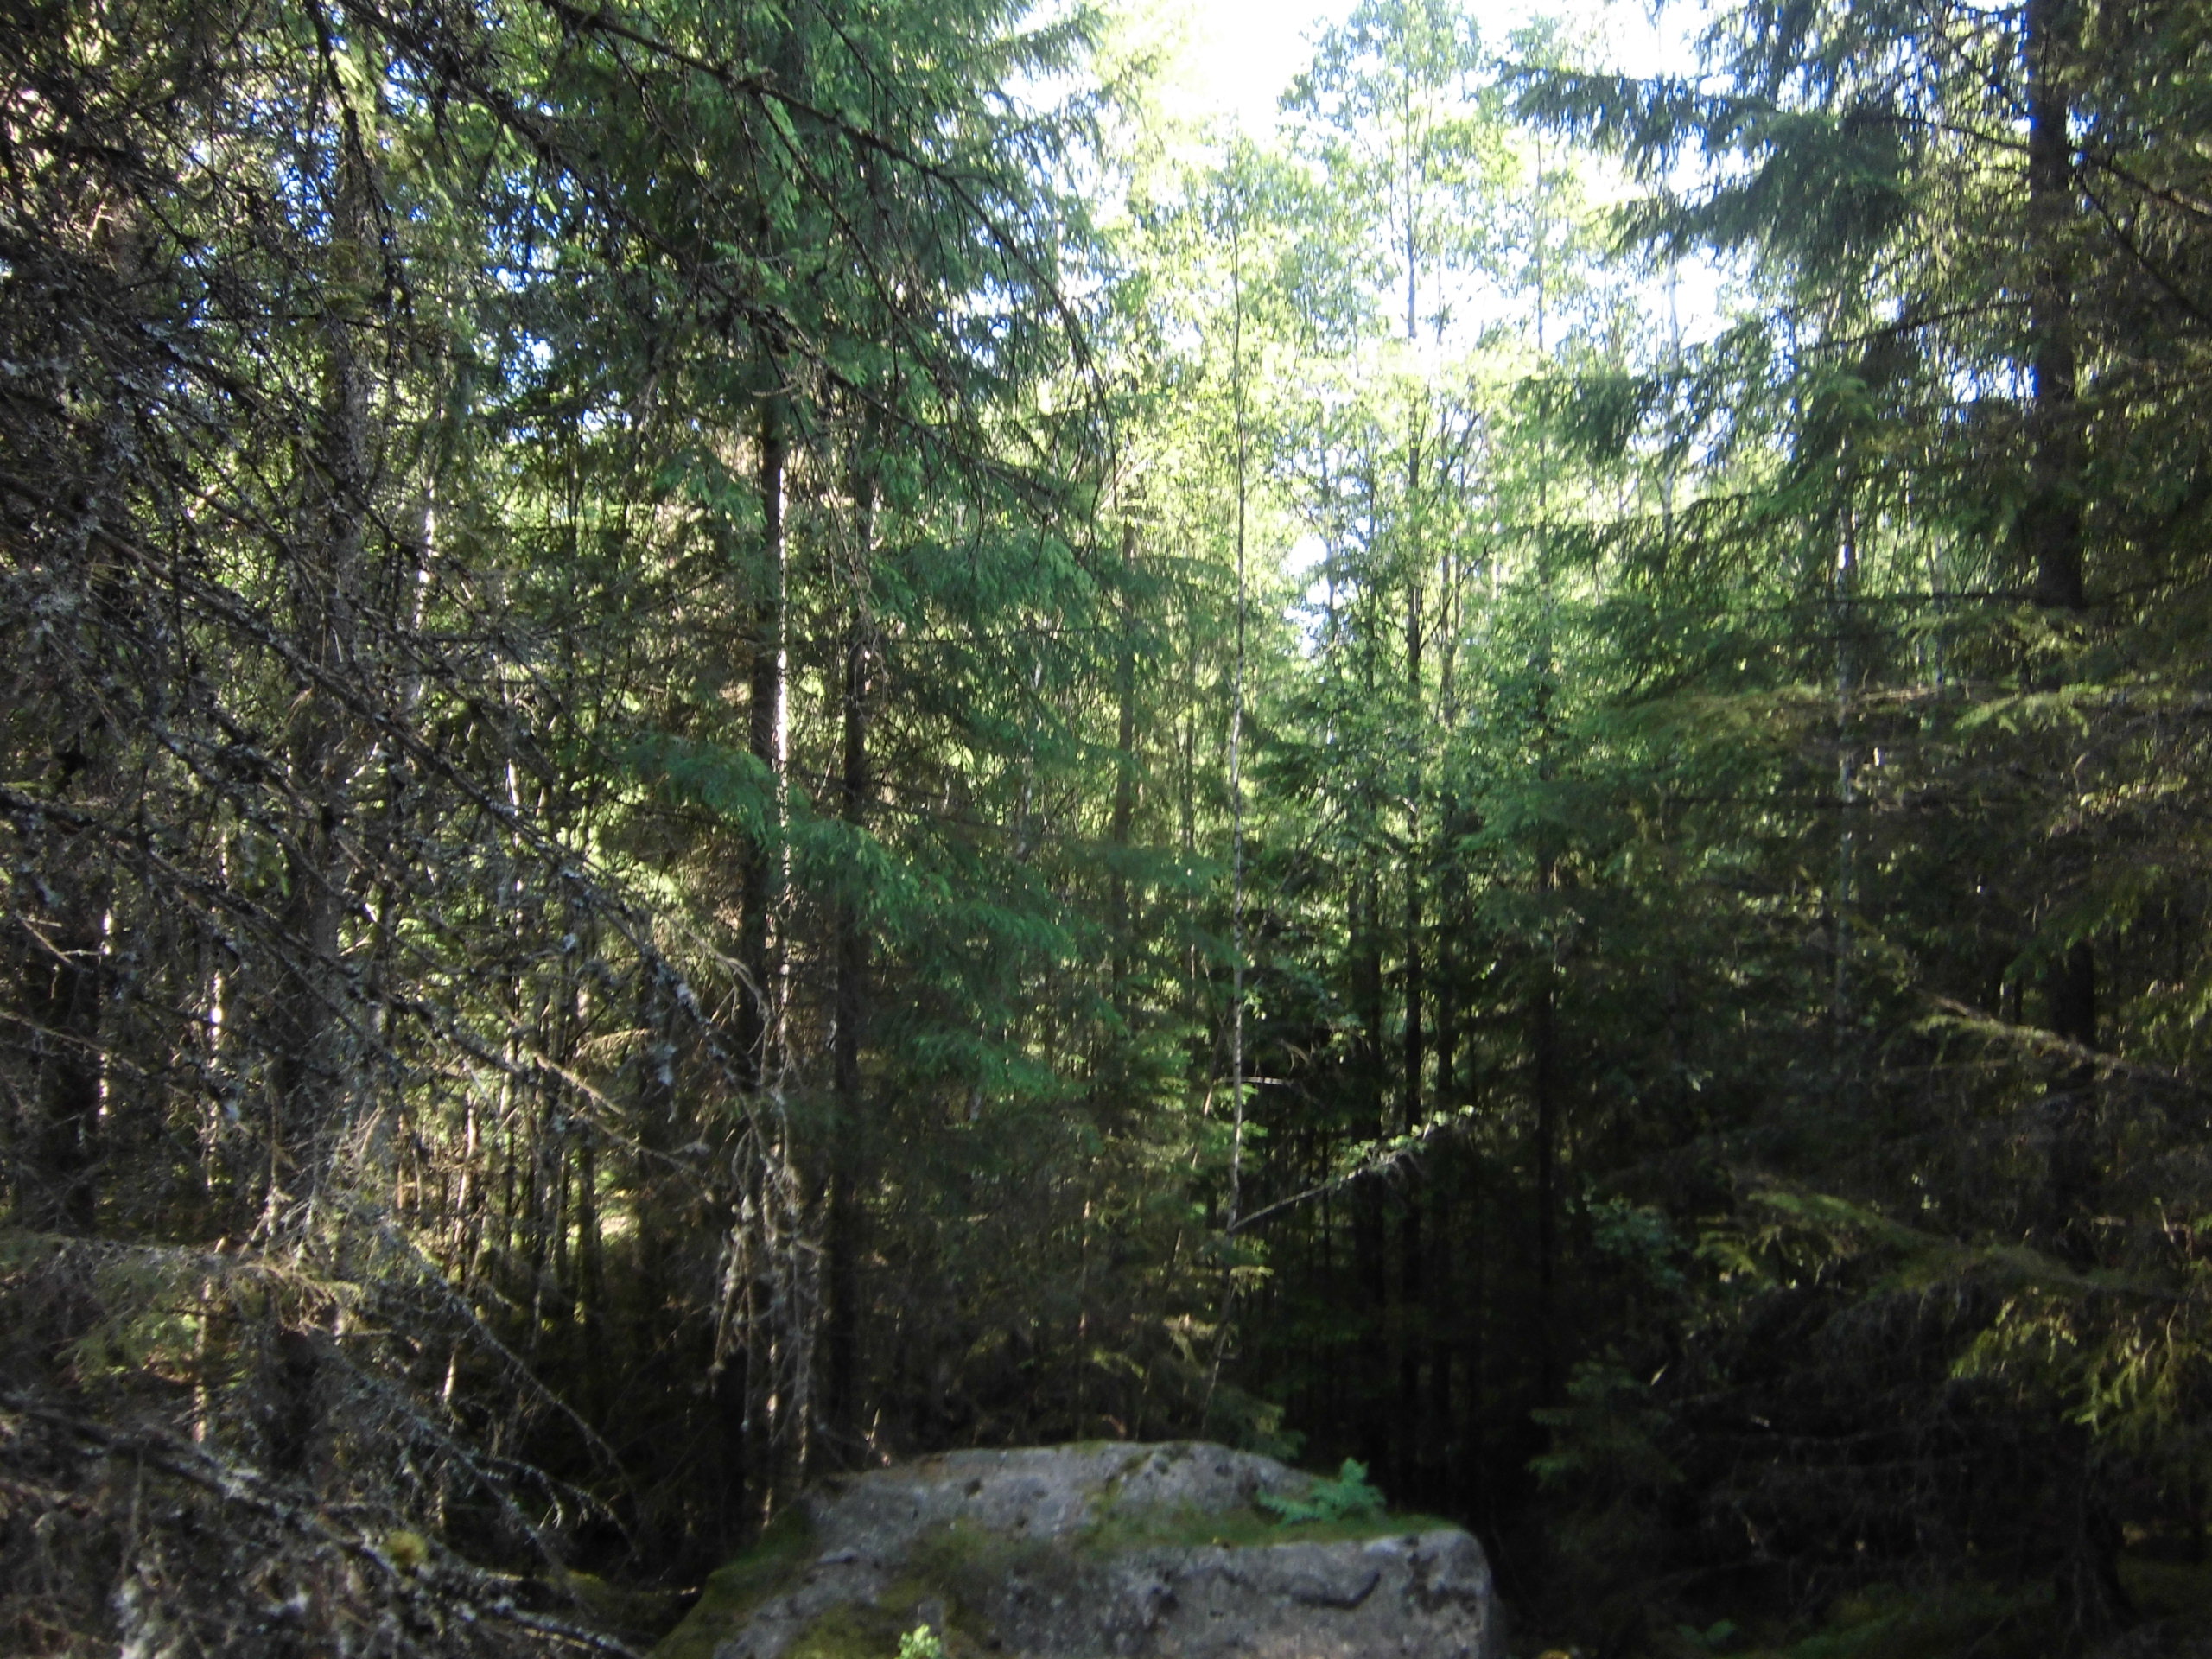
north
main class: Woodland
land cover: Spruce dominated coniferous woodland
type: boreal forest
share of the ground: 50 - 75 %
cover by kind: coniferous forest trees 50 %, shrubs 15 %, lichens and mosses 15 %, broadleaved forest trees 10 %, herbaceous plants 10 %
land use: Forestry
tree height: > 5 m
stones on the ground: > 50 %
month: July
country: SE
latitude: 57.1976
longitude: 14.7796
